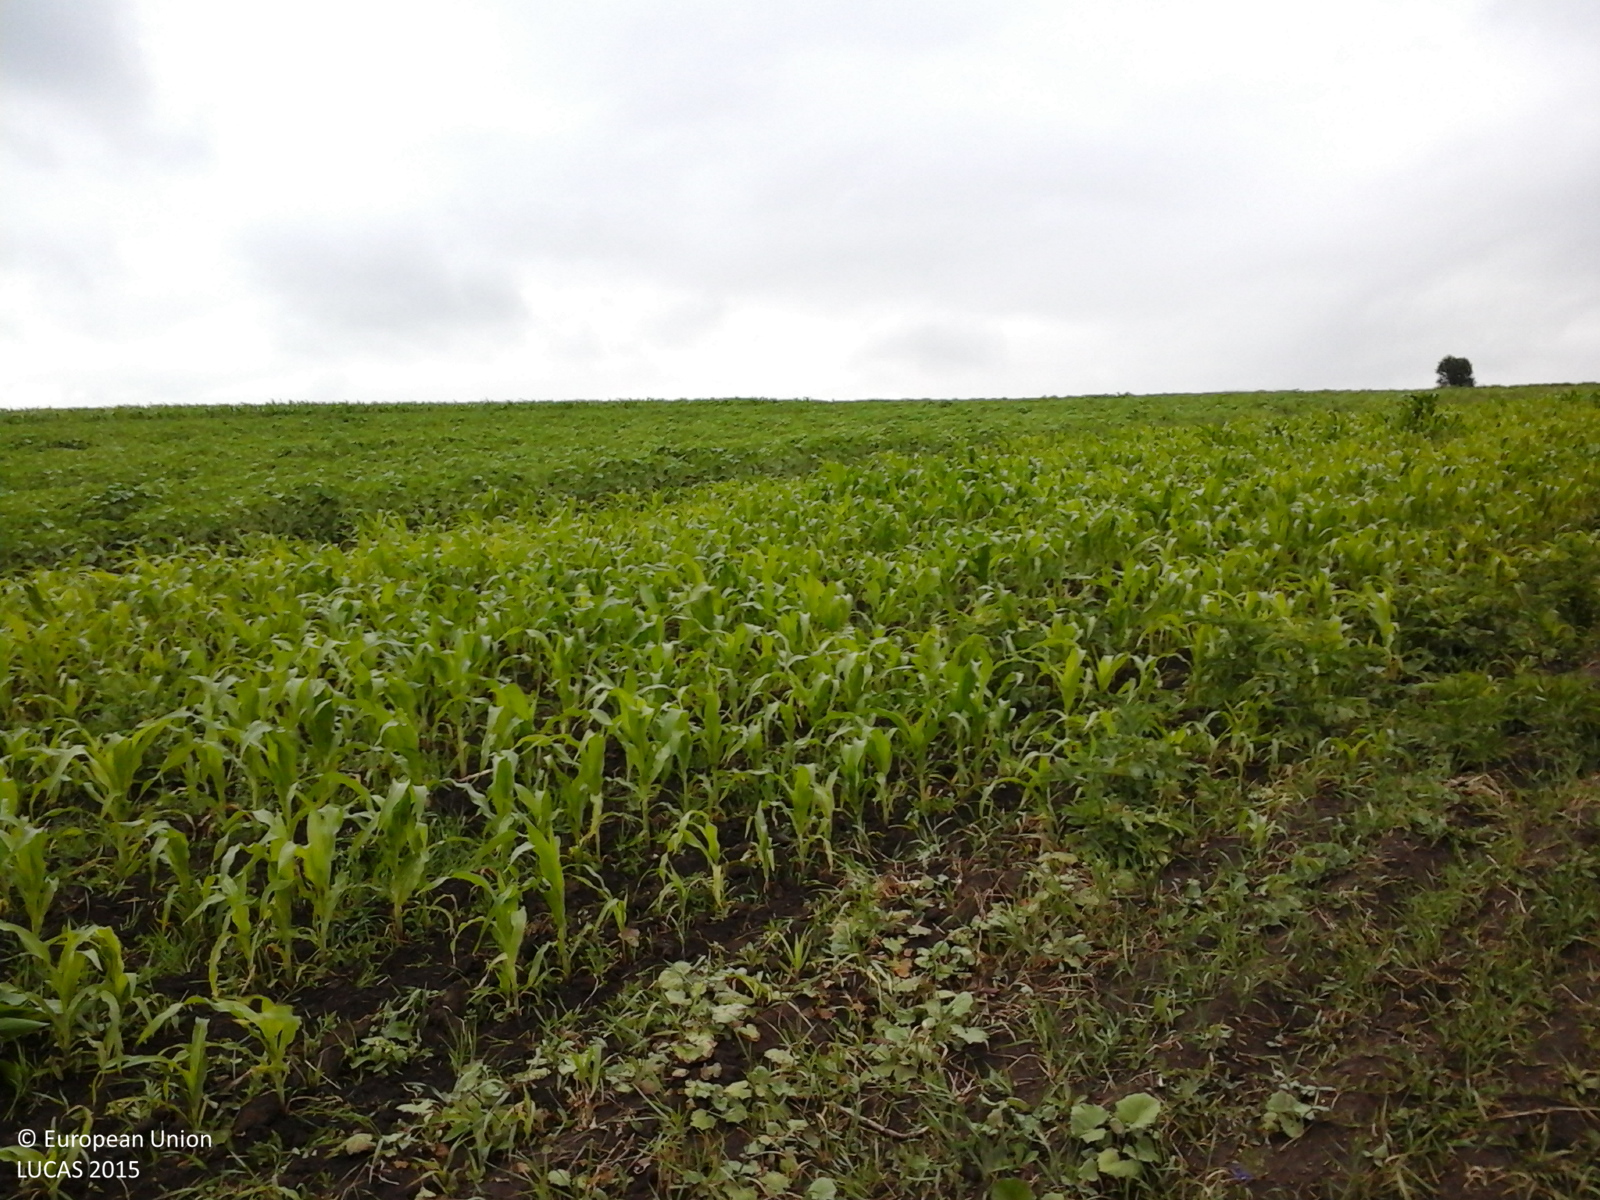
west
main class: Cropland
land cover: Soya
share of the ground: > 75 %
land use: Agriculture (excluding fallow land and kitchen gardens)
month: June
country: RO
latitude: 47.9918
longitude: 26.5354
